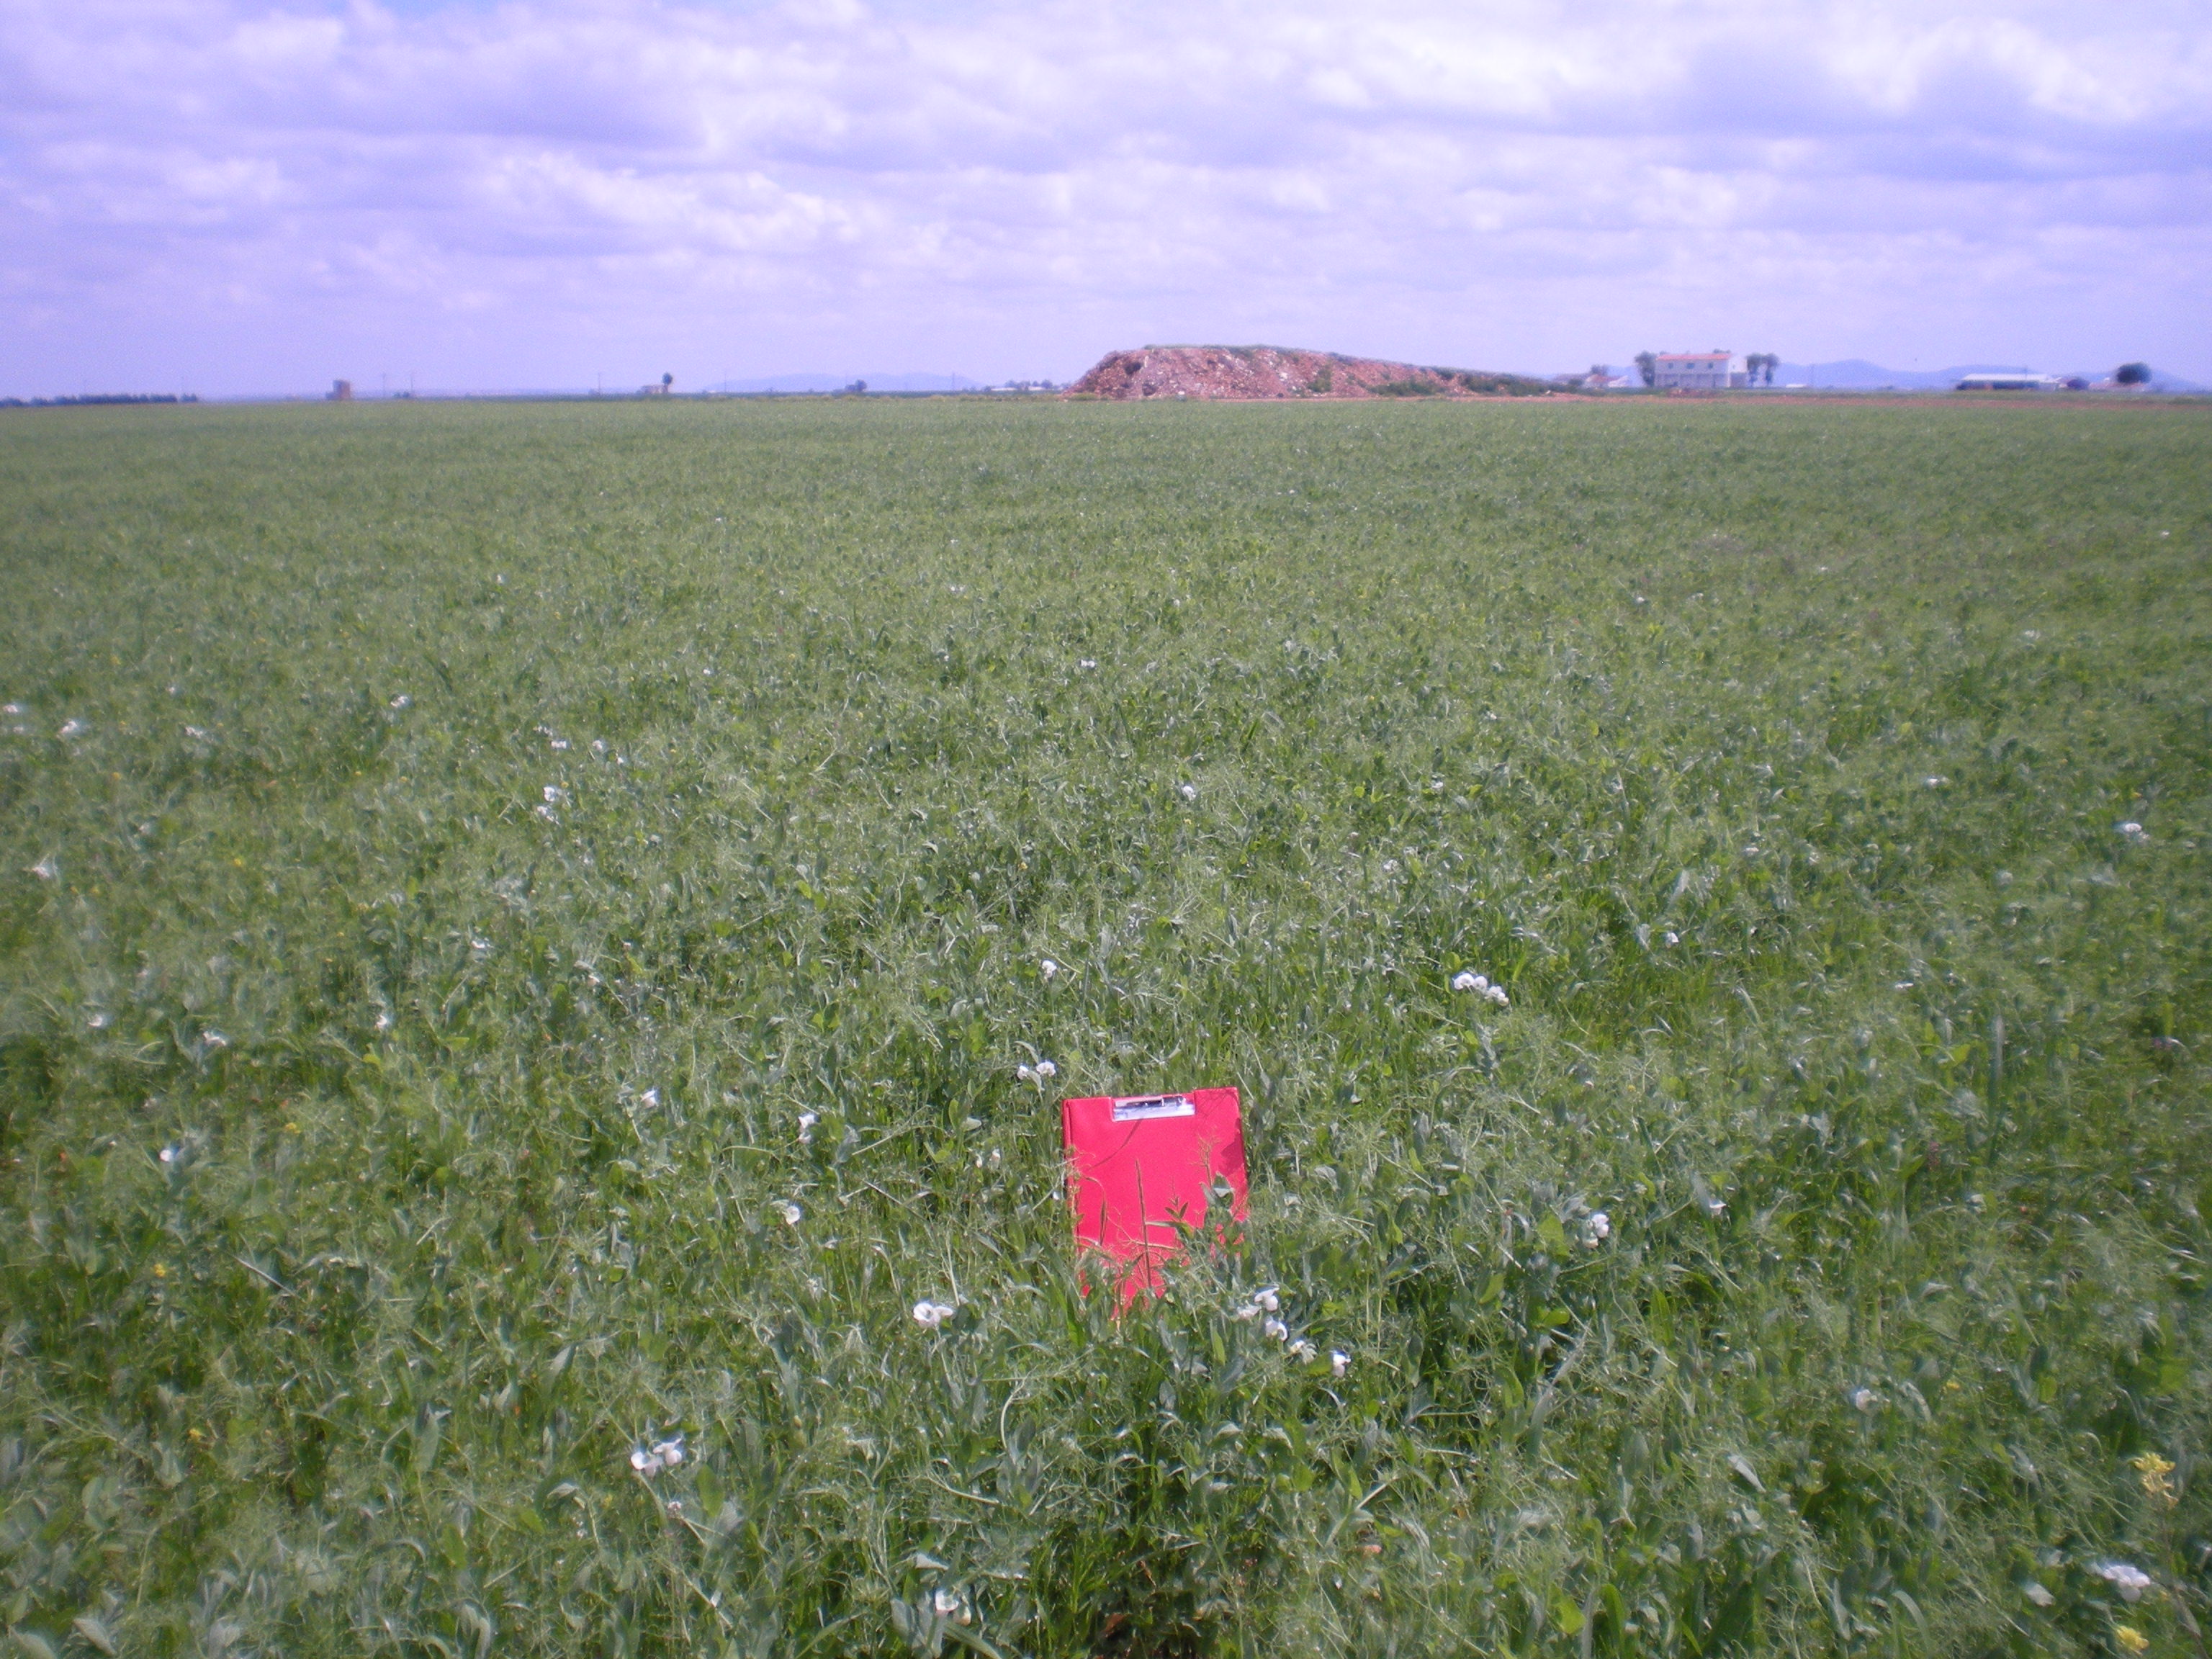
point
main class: Cropland
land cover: Other fresh vegetables
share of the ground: 50 - 75 %
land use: Agriculture (excluding fallow land and kitchen gardens)
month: April
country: ES
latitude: 38.9946
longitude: -3.5361
